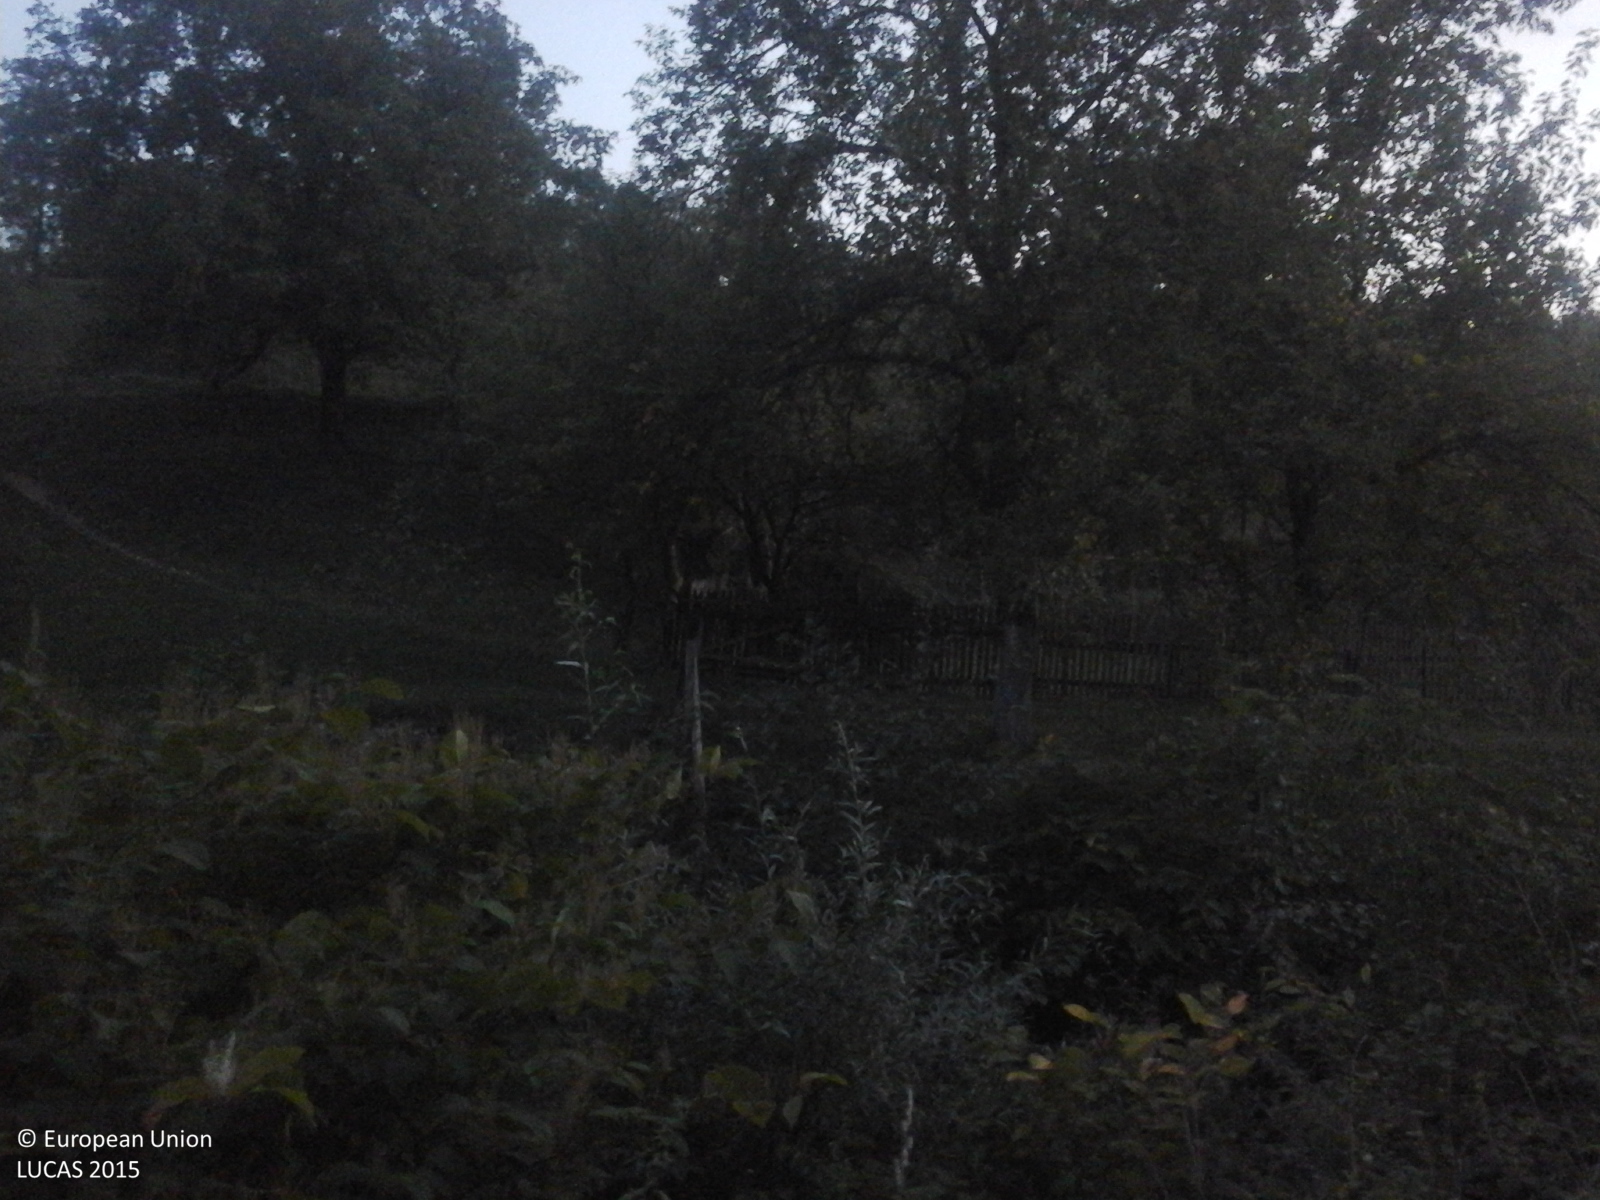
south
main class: Cropland
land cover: Apple fruit
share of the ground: 25 - 50 %
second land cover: Grassland without tree/shrub cover
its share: > 75 %
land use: Agriculture (excluding fallow land and kitchen gardens)
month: September
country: RO
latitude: 45.2336
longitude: 22.3332
